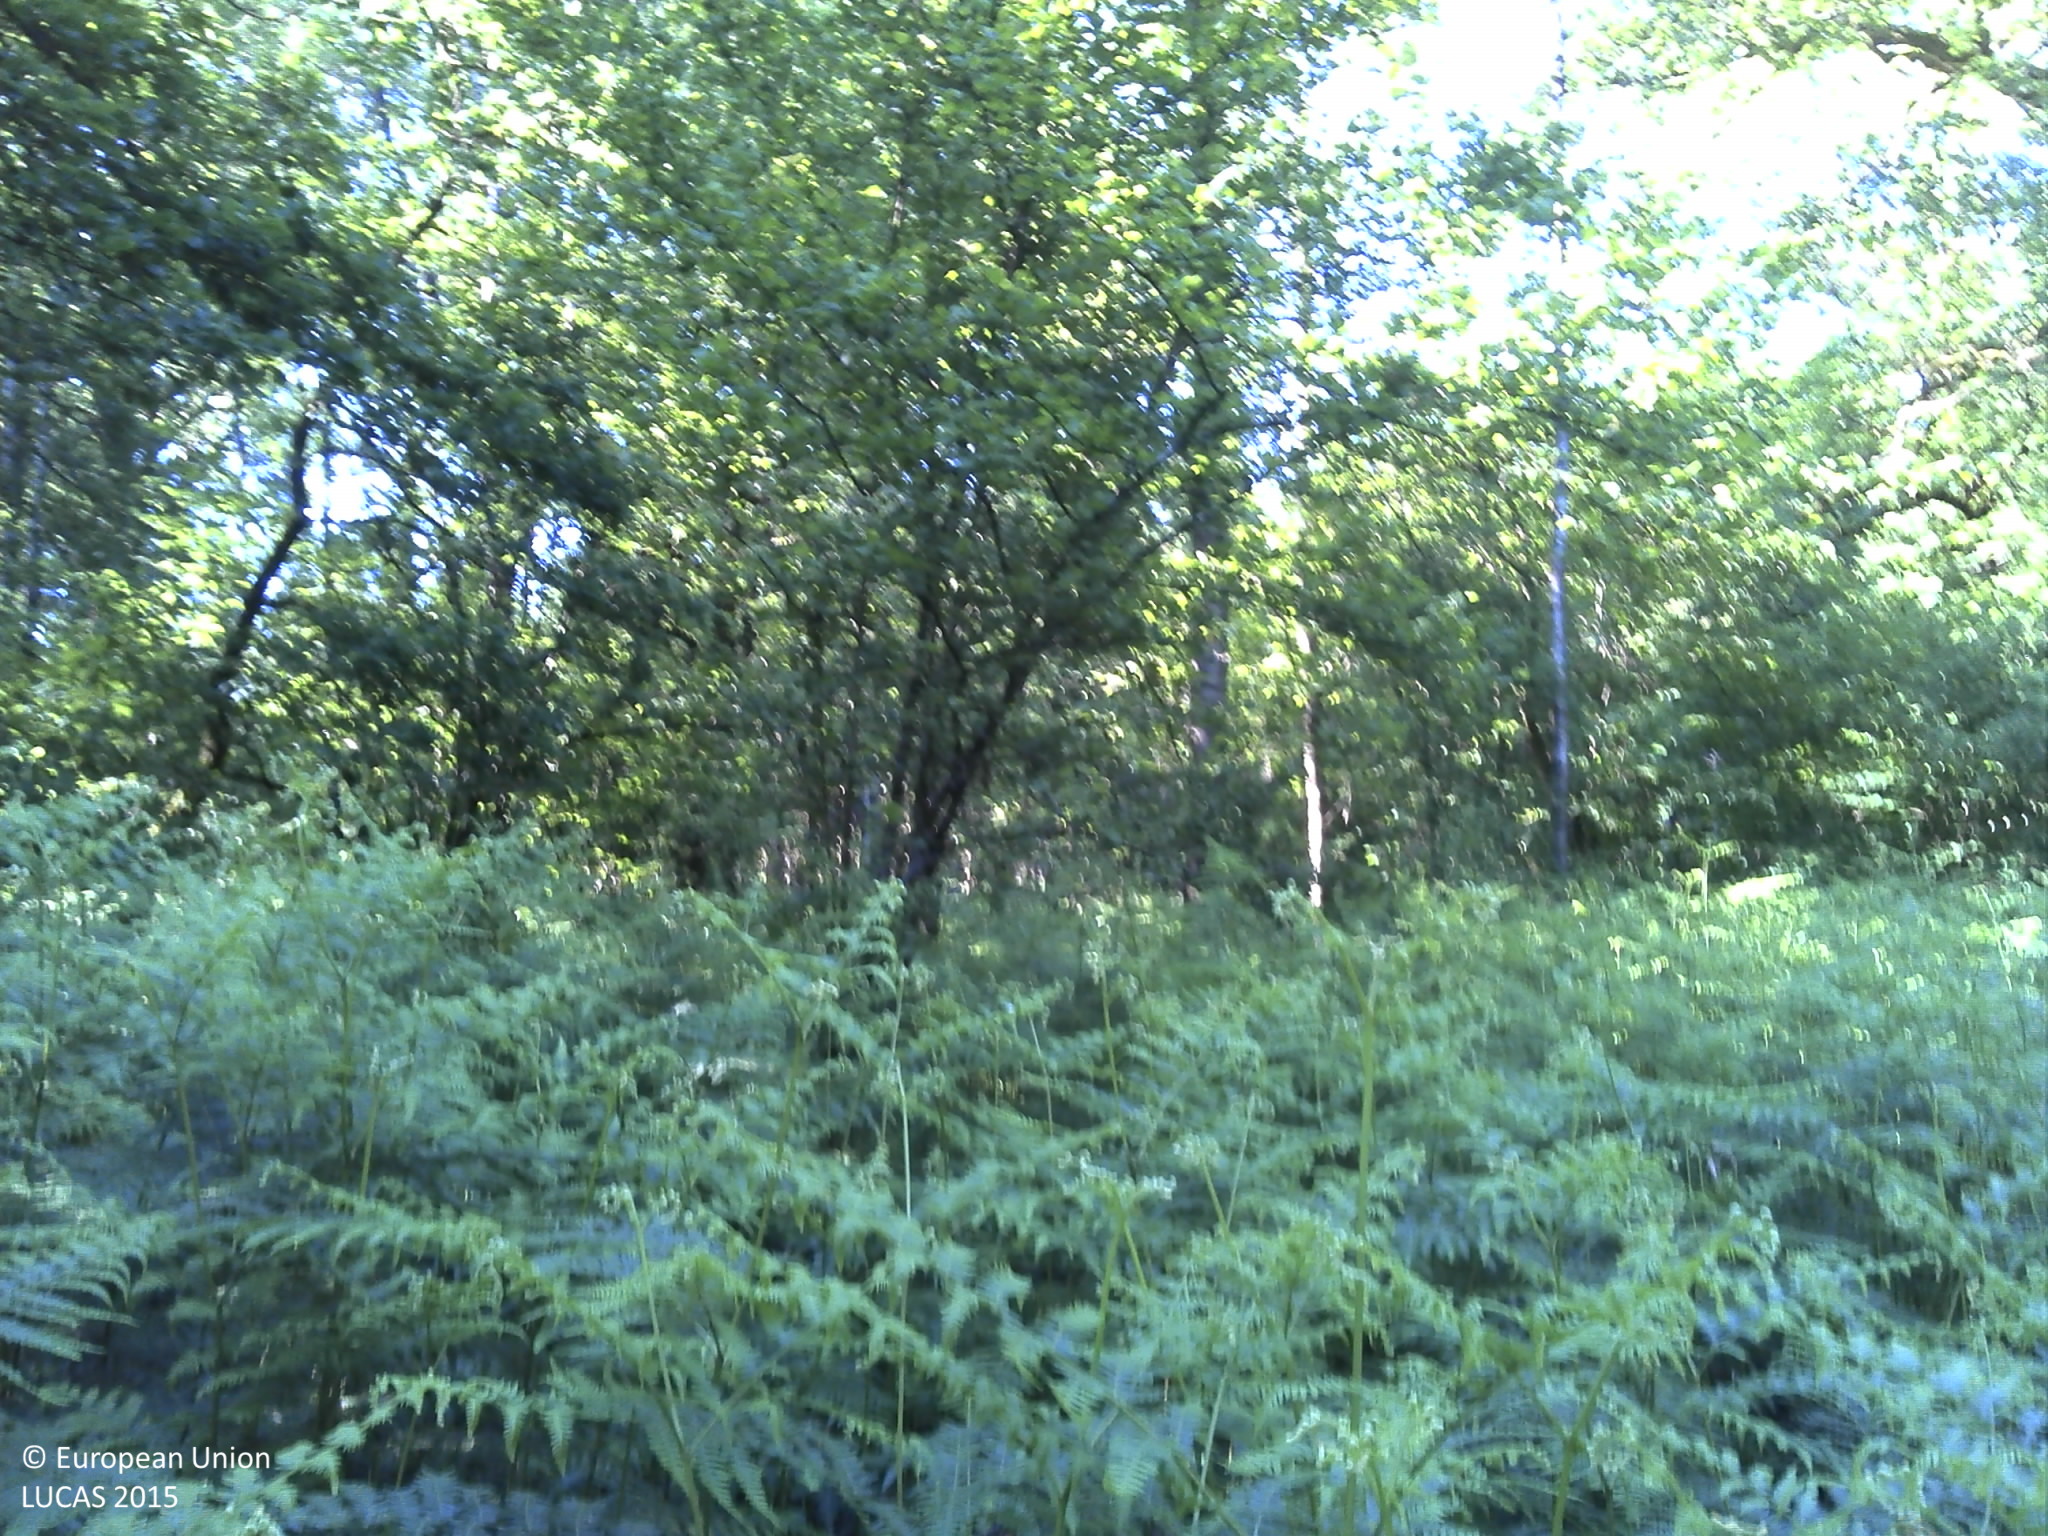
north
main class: Woodland
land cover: Broadleaved woodland
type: acidophilous oak and oak-birch forest
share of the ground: 50 - 75 %
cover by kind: broadleaved forest trees 60 %, herbaceous plants 35 %, lichens and mosses 5 %
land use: Forestry
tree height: > 5 m
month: June
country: FR
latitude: 49.9549
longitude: 4.7420
